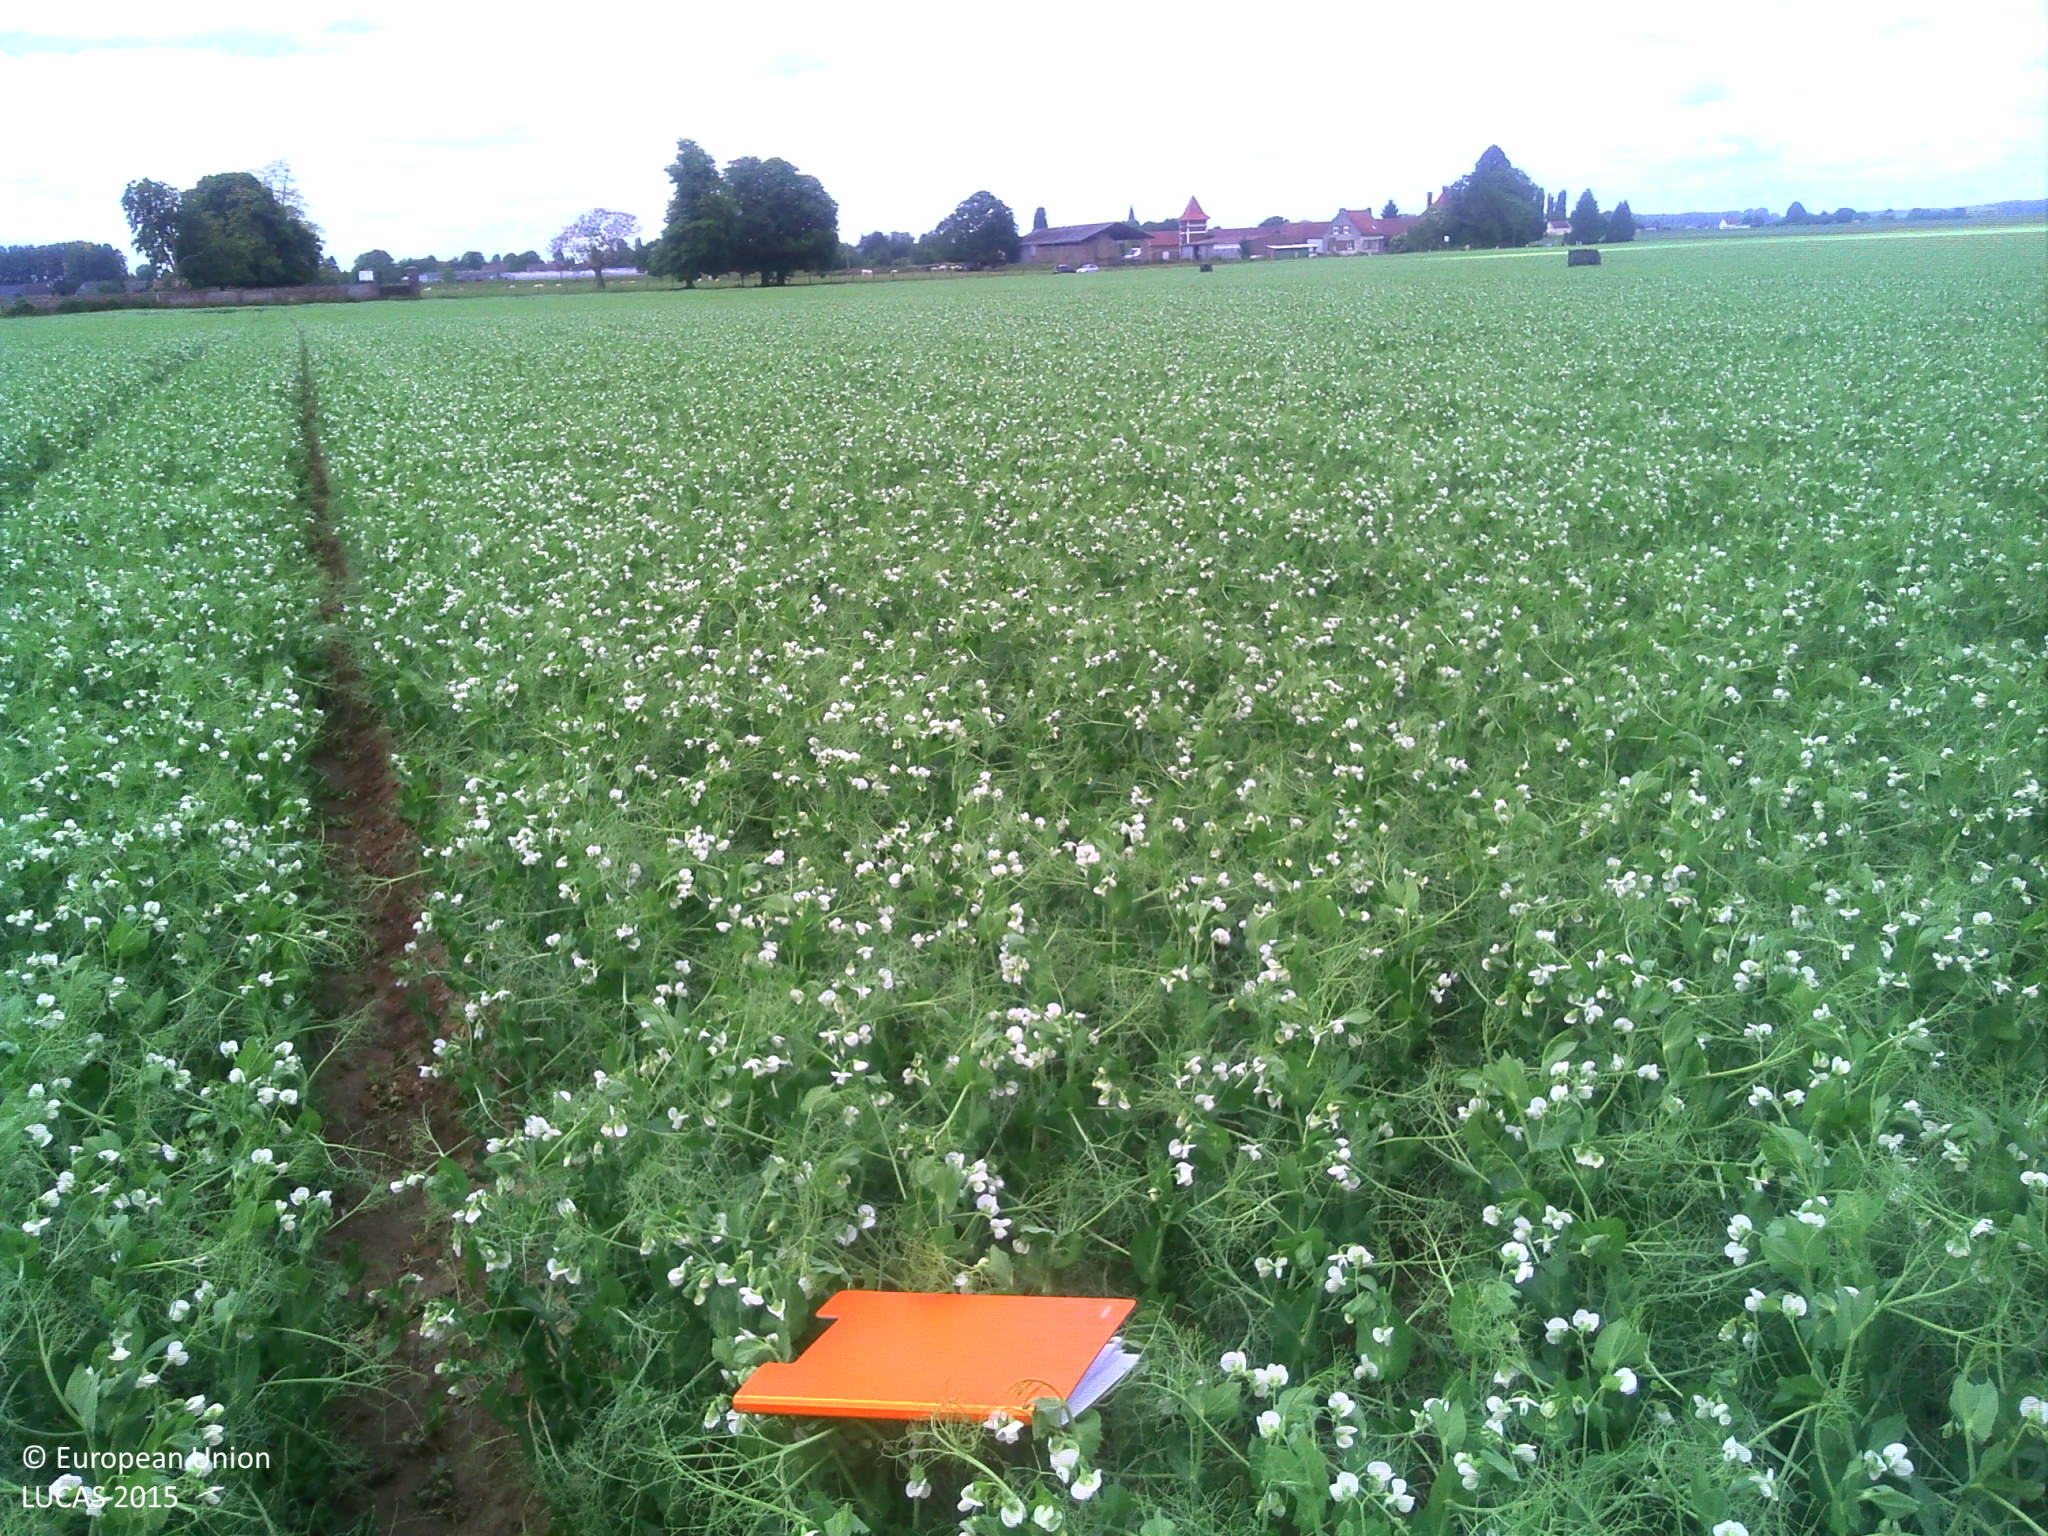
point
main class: Cropland
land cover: Dry pulses
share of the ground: > 75 %
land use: Agriculture (excluding fallow land and kitchen gardens)
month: June
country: FR
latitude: 49.7111
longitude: 3.2100
